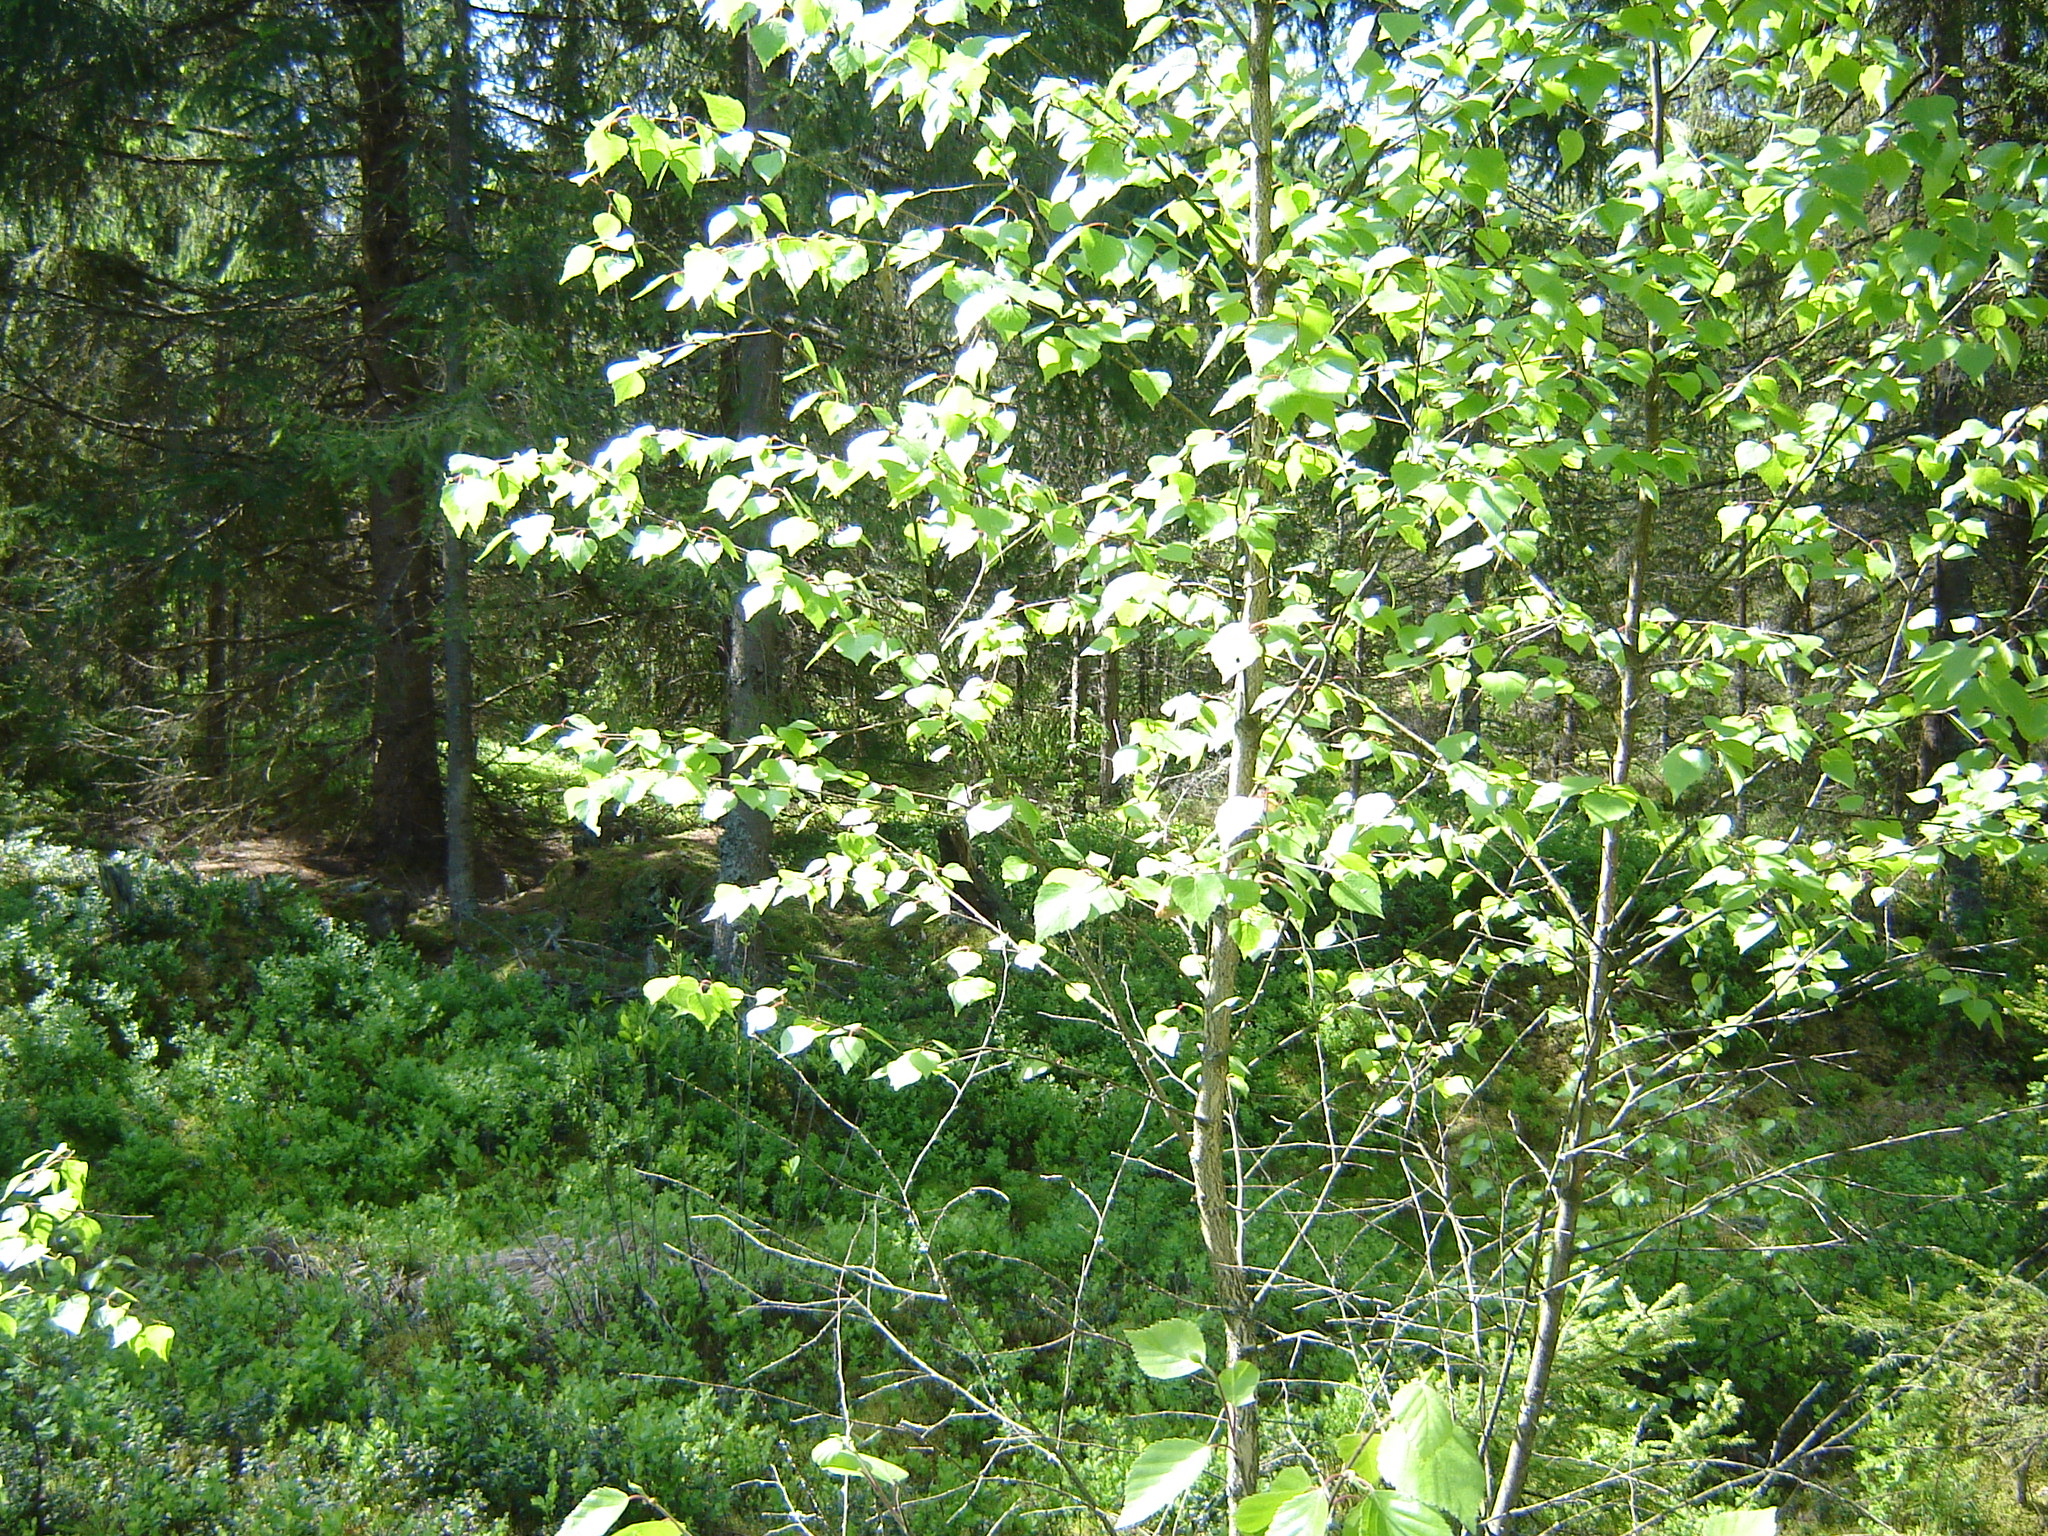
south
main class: Woodland
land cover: Pine dominated mixed woodland
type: hemiboreal forest and nemoral coniferous forest and mixed broadleaved-coniferous forest
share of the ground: 50 - 75 %
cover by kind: coniferous forest trees 40 %, broadleaved forest trees 30 %, lichens and mosses 30 %
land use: Forestry
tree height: > 5 m
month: May
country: LT
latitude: 55.7044
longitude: 25.2835
